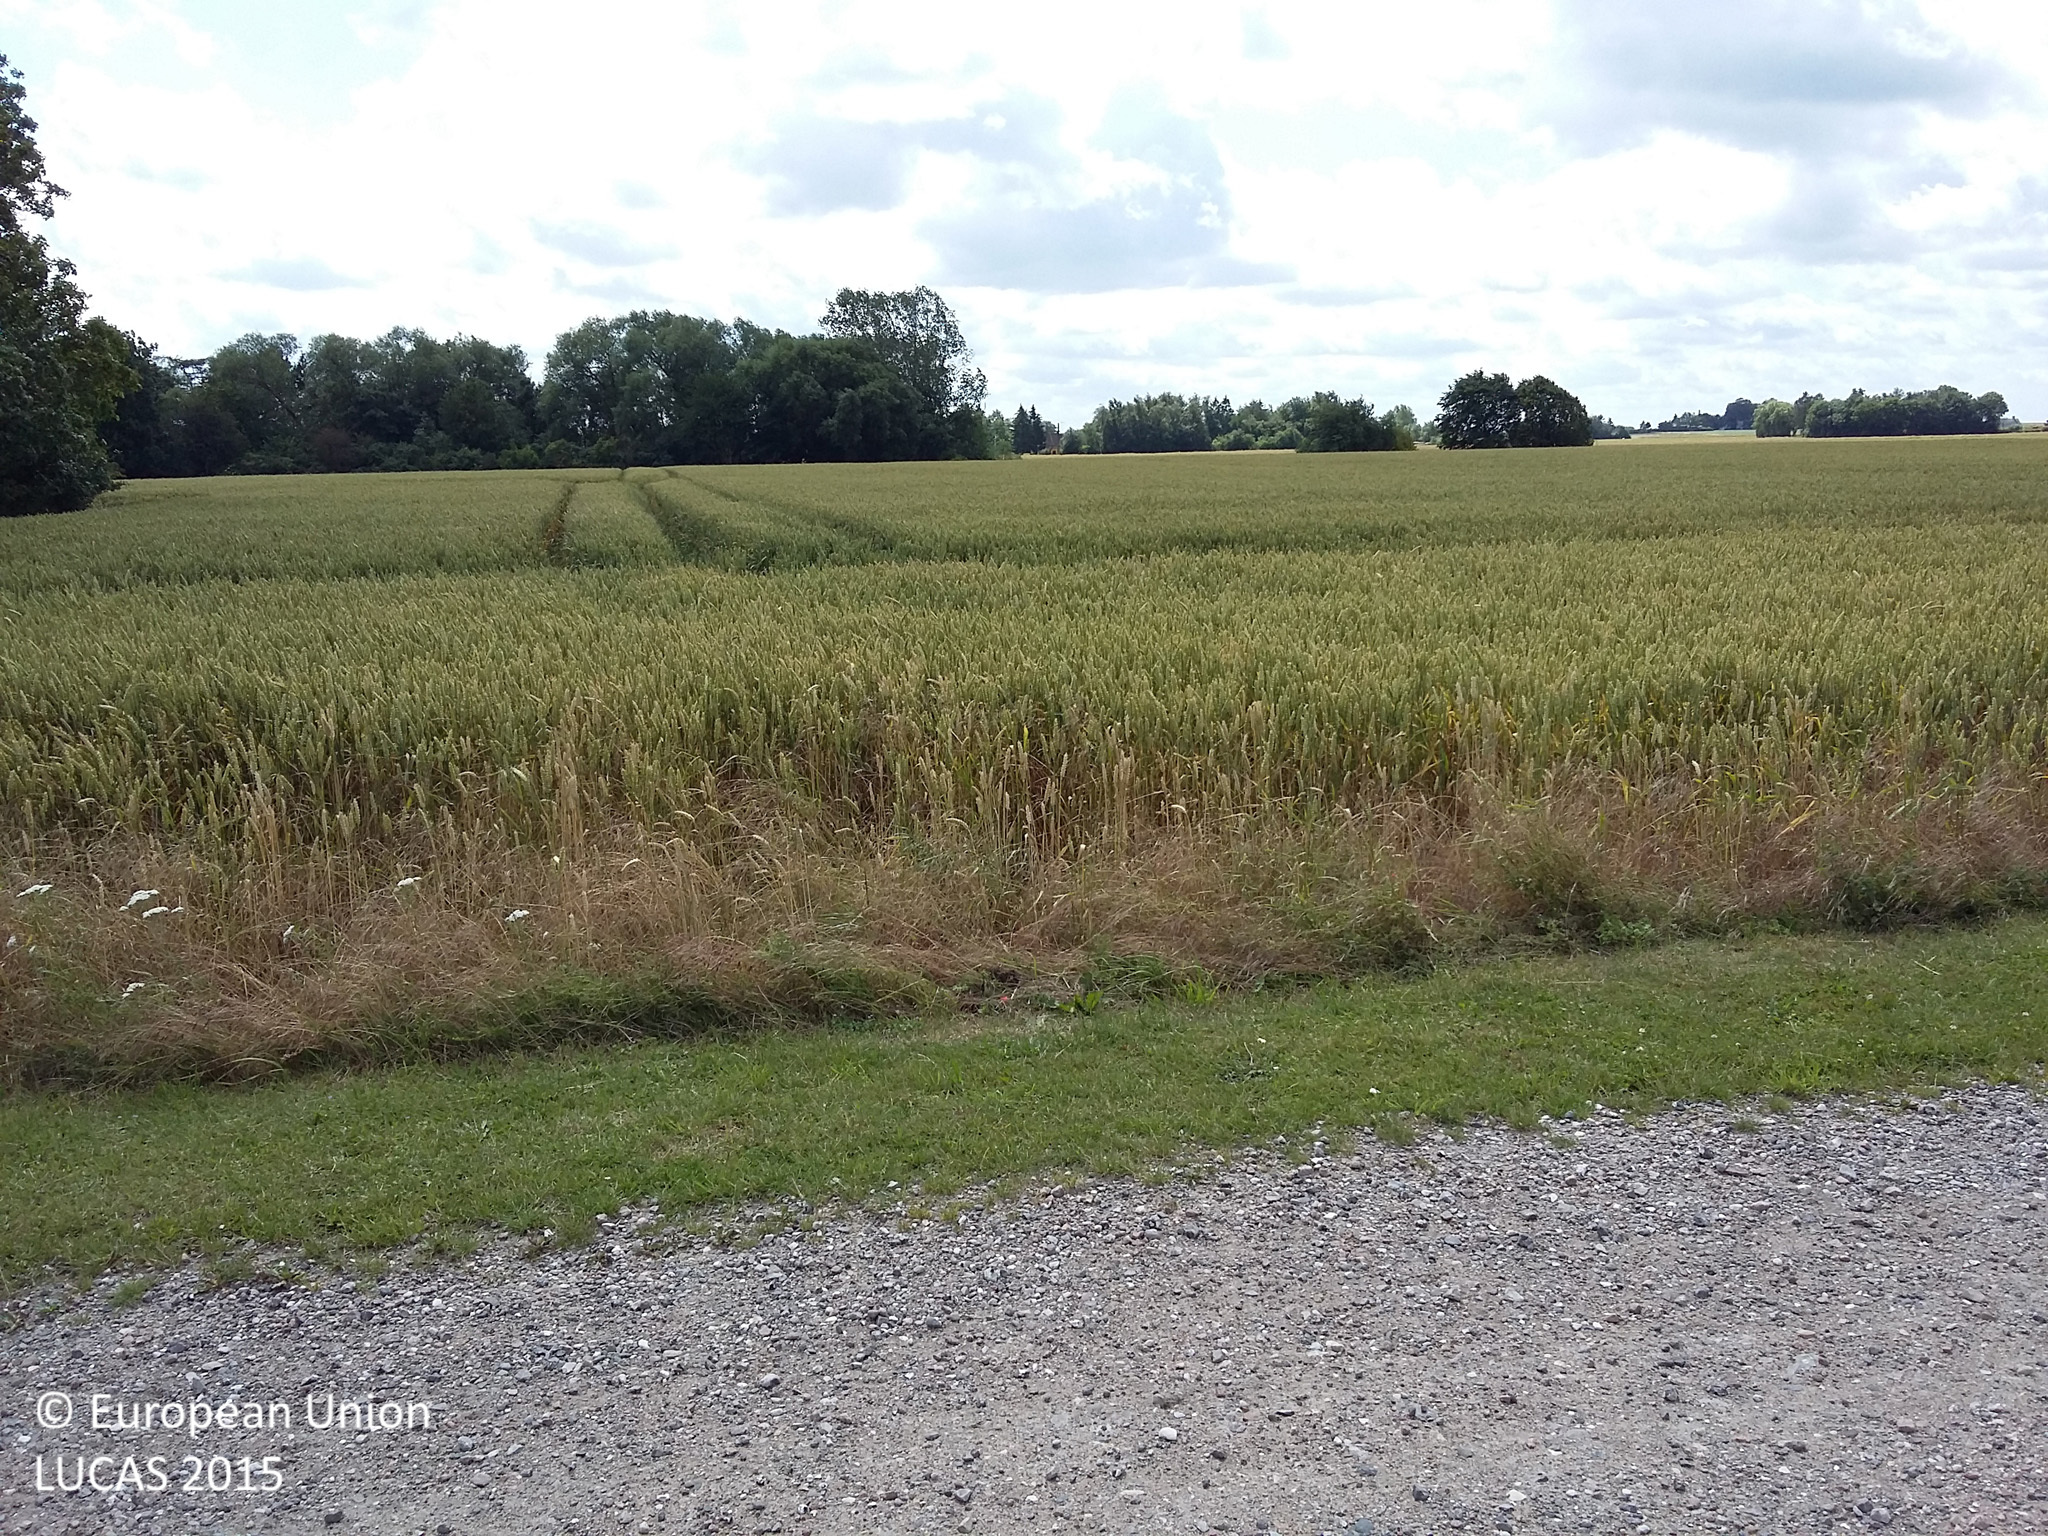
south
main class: Grassland
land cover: Grassland without tree/shrub cover
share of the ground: > 75 %
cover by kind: herbaceous plants 100 %
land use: Agriculture (excluding fallow land and kitchen gardens)
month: July
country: DK
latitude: 55.7625
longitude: 11.7355
